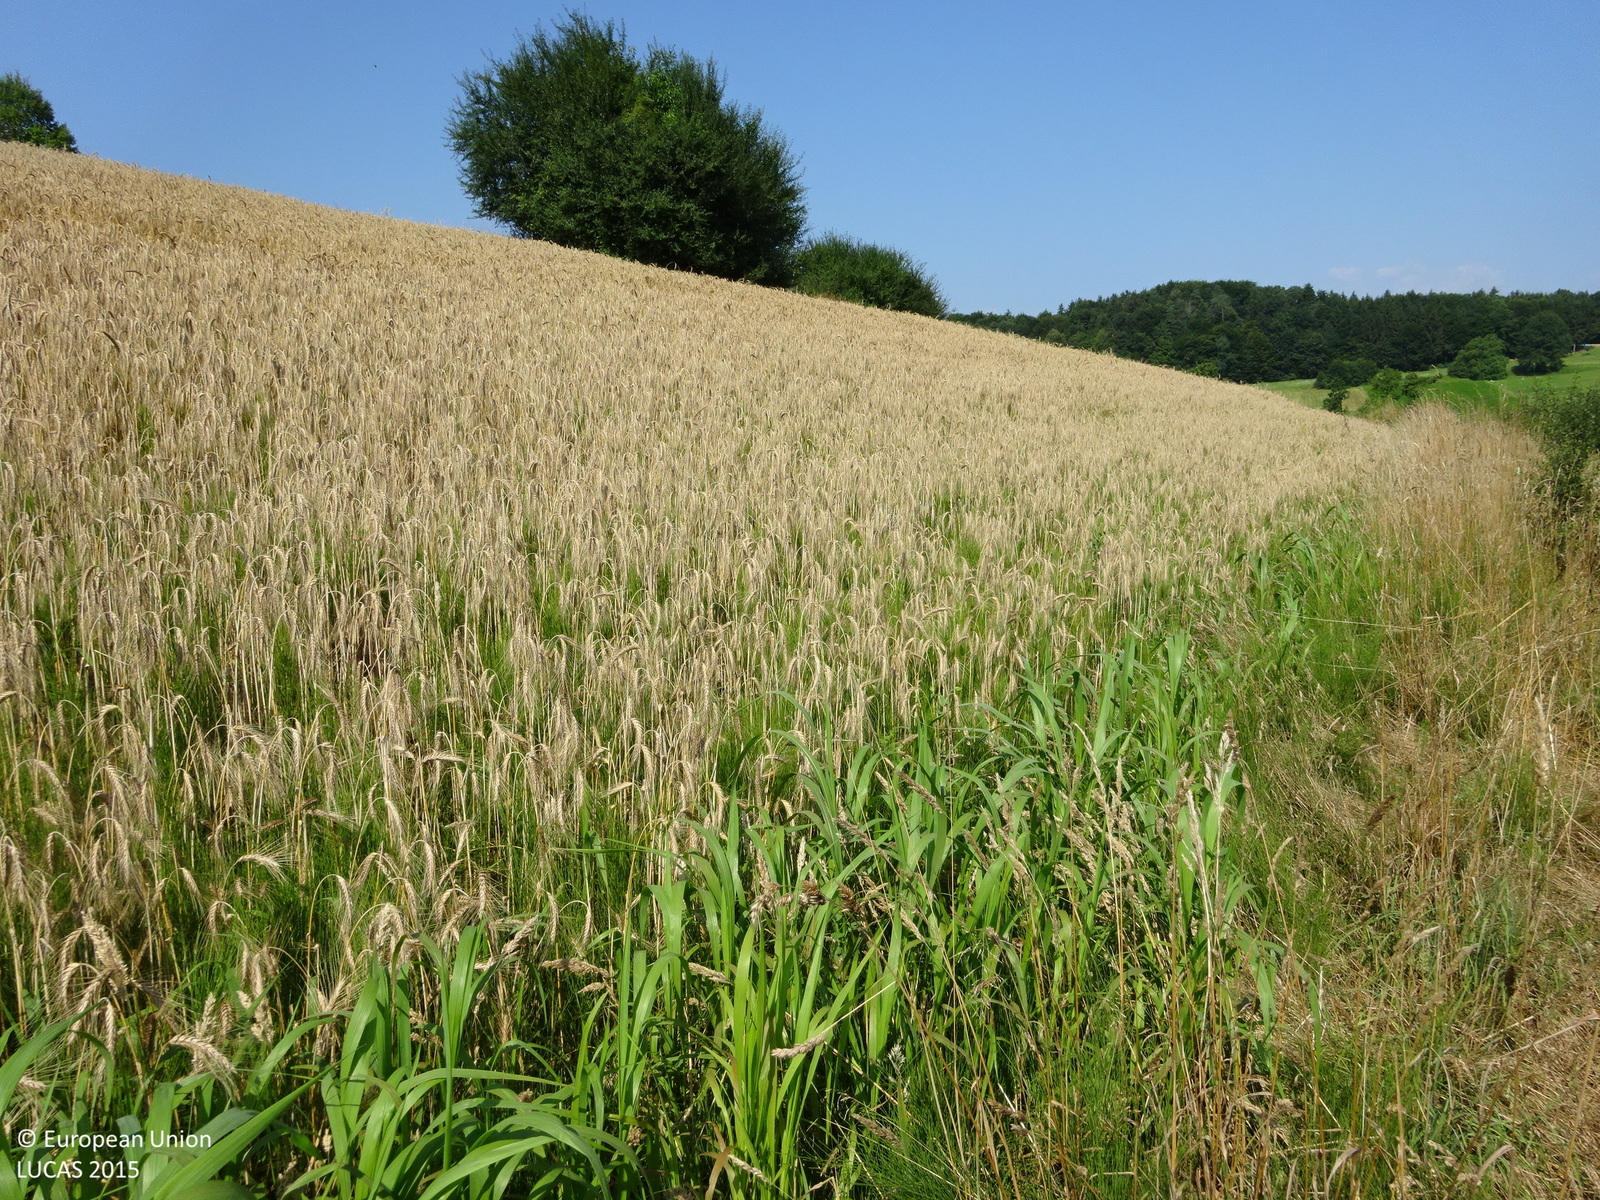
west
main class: Cropland
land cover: Barley
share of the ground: > 75 %
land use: Agriculture (excluding fallow land and kitchen gardens)
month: July
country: AT
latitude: 46.8252
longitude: 15.4656
